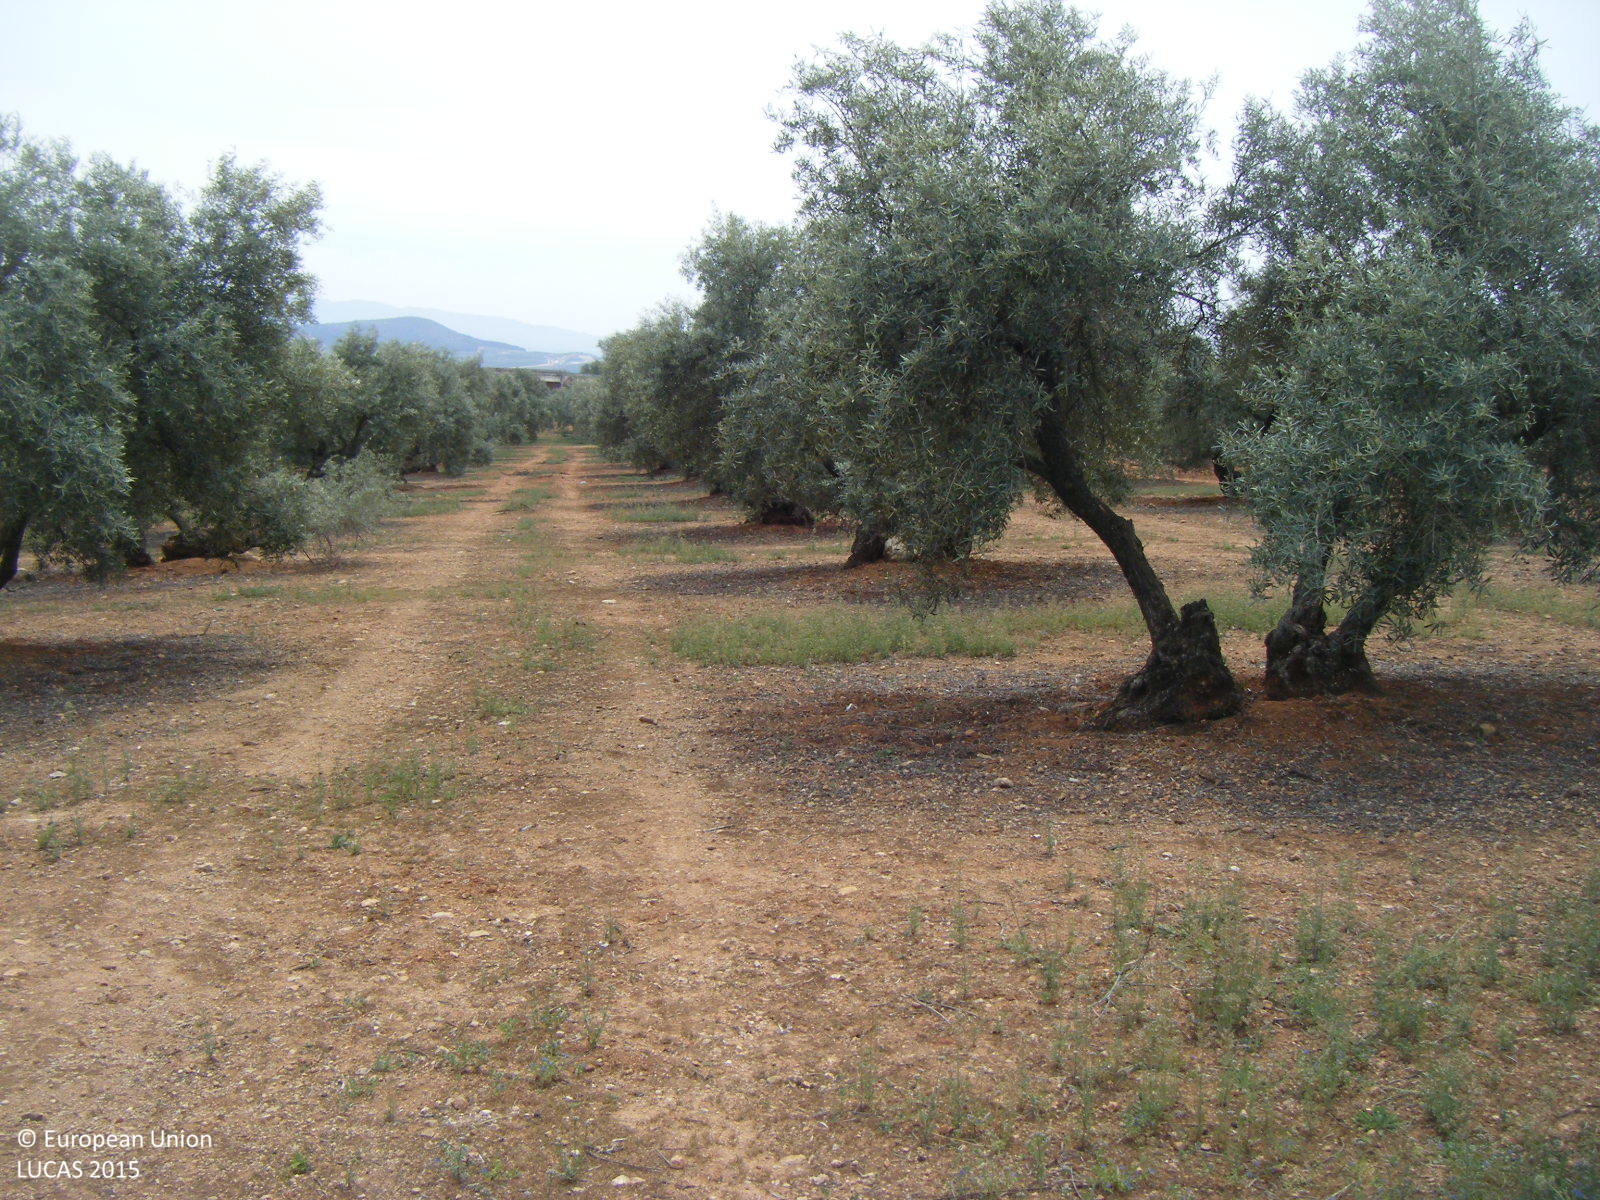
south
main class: Cropland
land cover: Olive groves
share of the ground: 25 - 50 %
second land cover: Spontaneously vegetated surfaces
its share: 50 - 75 %
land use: Agriculture (excluding fallow land and kitchen gardens)
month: April
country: ES
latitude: 37.1586
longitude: -4.7641
